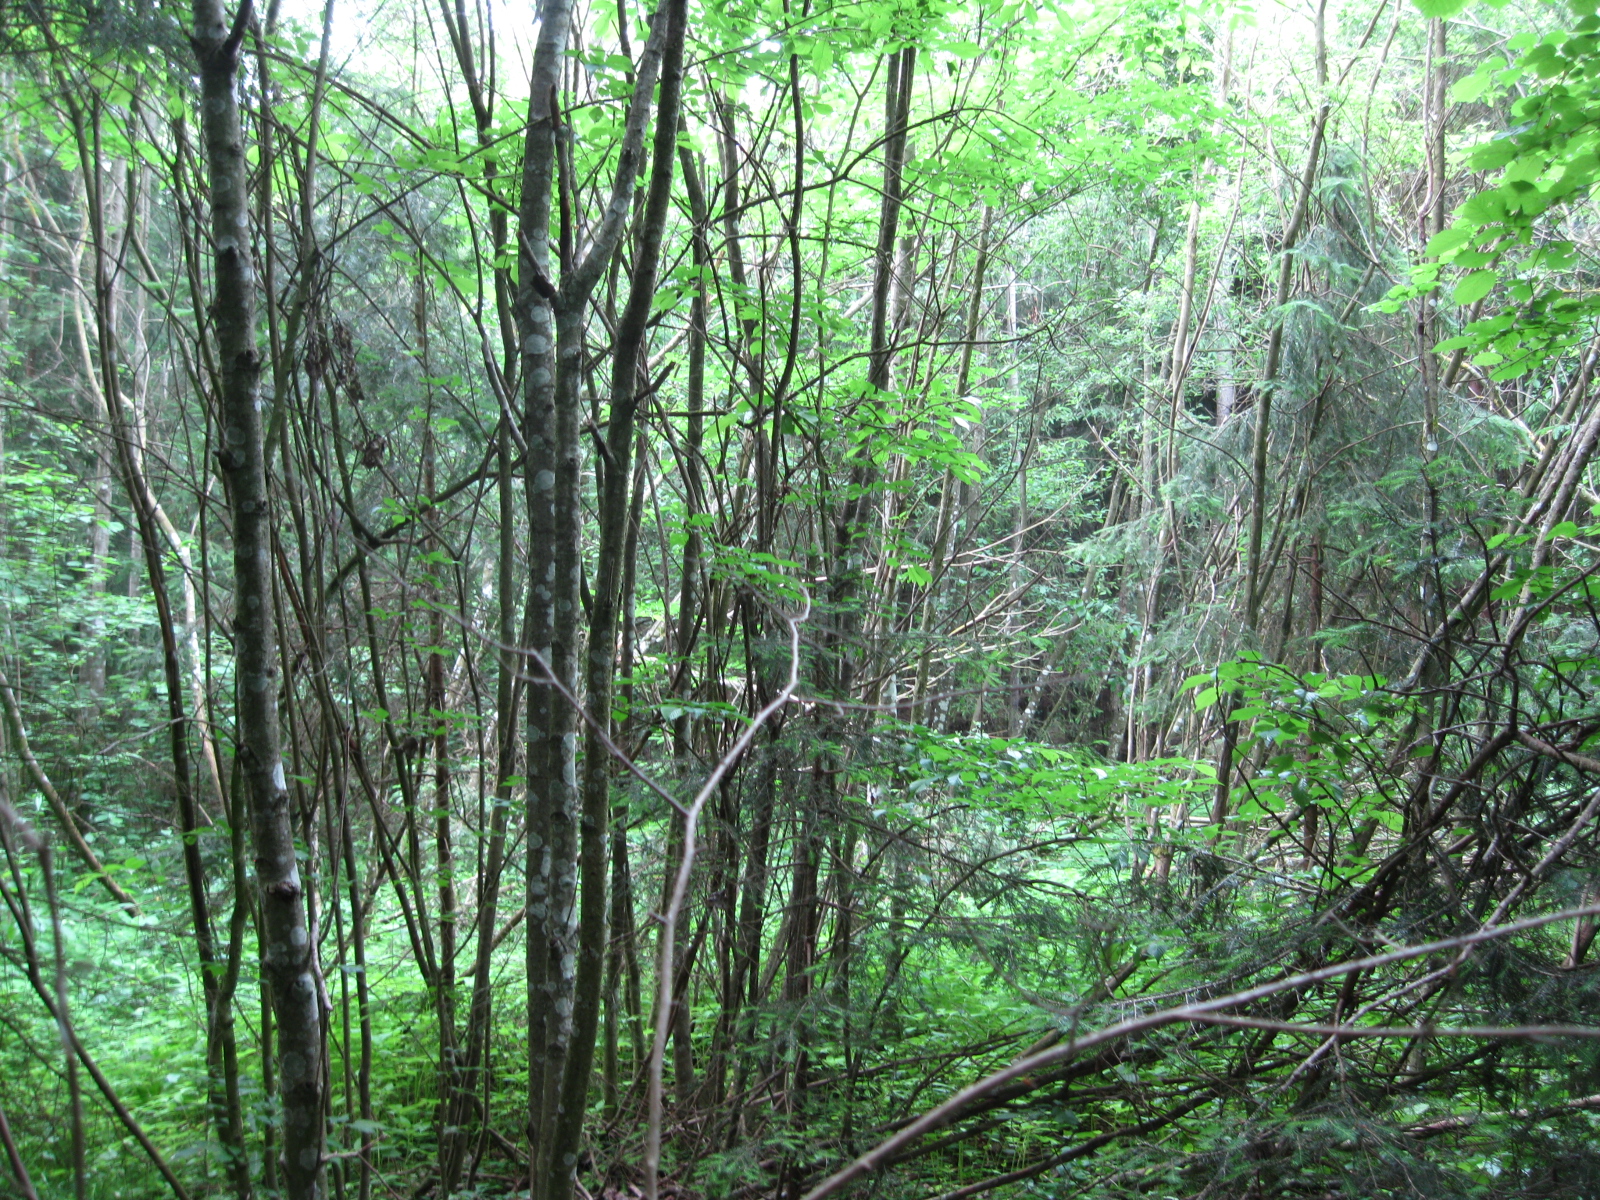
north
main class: Woodland
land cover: Spruce dominated mixed woodland
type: hemiboreal forest and nemoral coniferous forest and mixed broadleaved-coniferous forest
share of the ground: > 75 %
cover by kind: broadleaved forest trees 50 %, coniferous forest trees 40 %, herbaceous plants 10 %
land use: Forestry
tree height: > 5 m
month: June
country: LT
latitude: 55.1965
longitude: 24.1539
